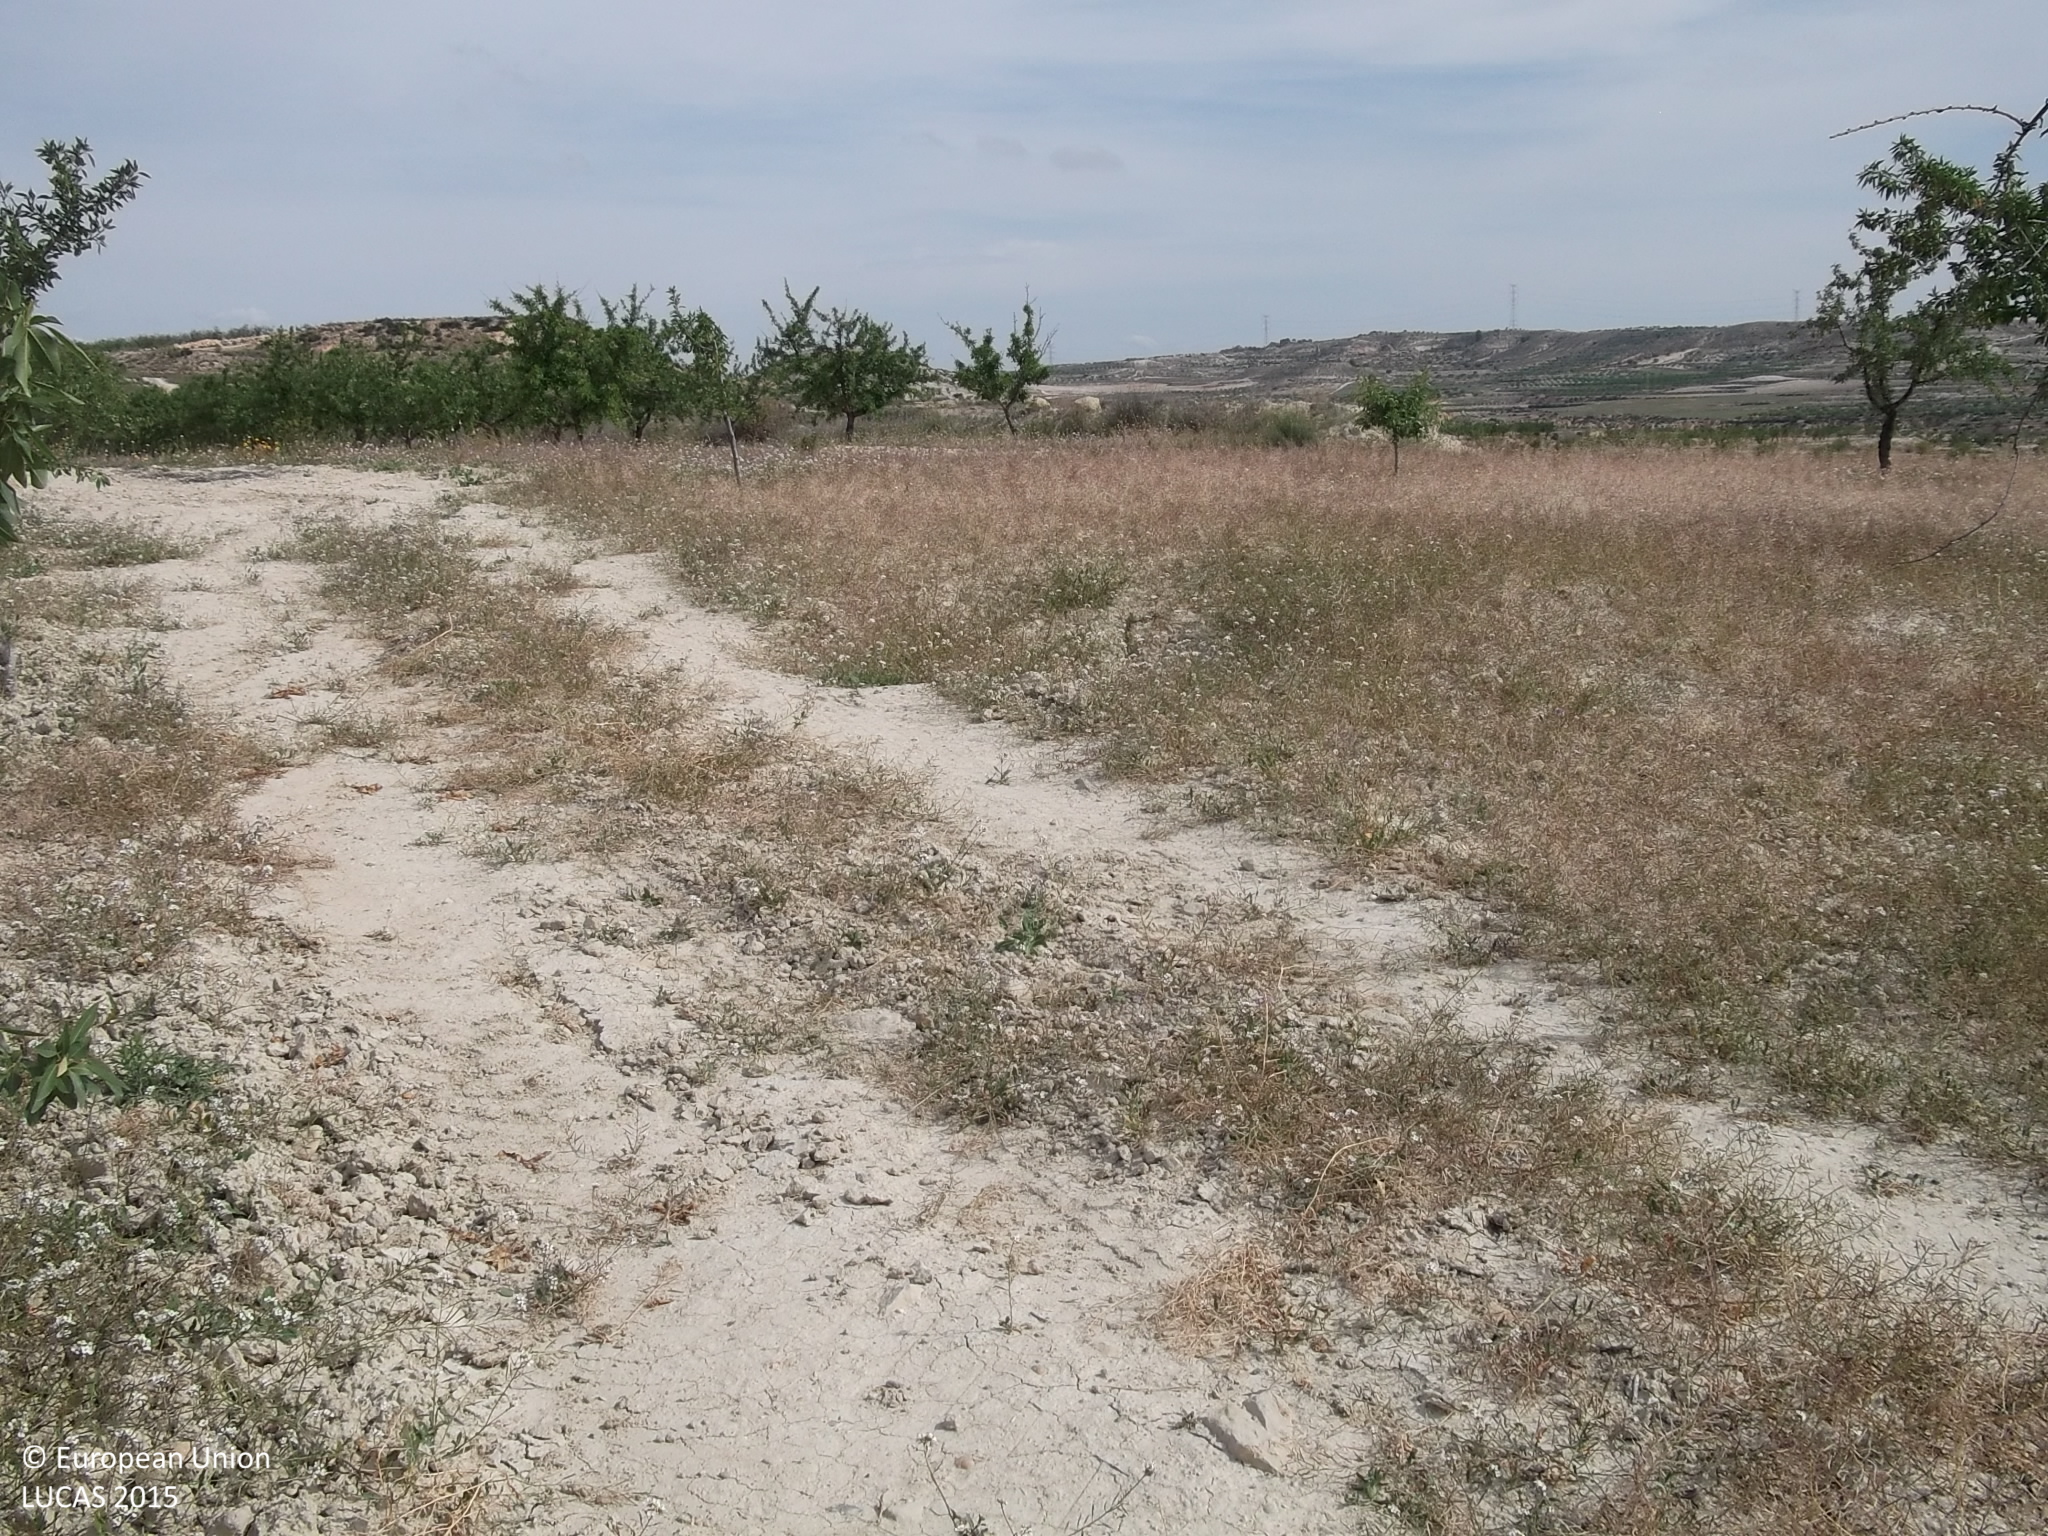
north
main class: Cropland
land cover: Nuts trees
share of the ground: 10 - 25 %
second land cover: Spontaneously vegetated surfaces
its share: > 75 %
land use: Agriculture (excluding fallow land and kitchen gardens)
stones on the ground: < 10 %
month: April
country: ES
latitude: 37.9202
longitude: -1.3940
